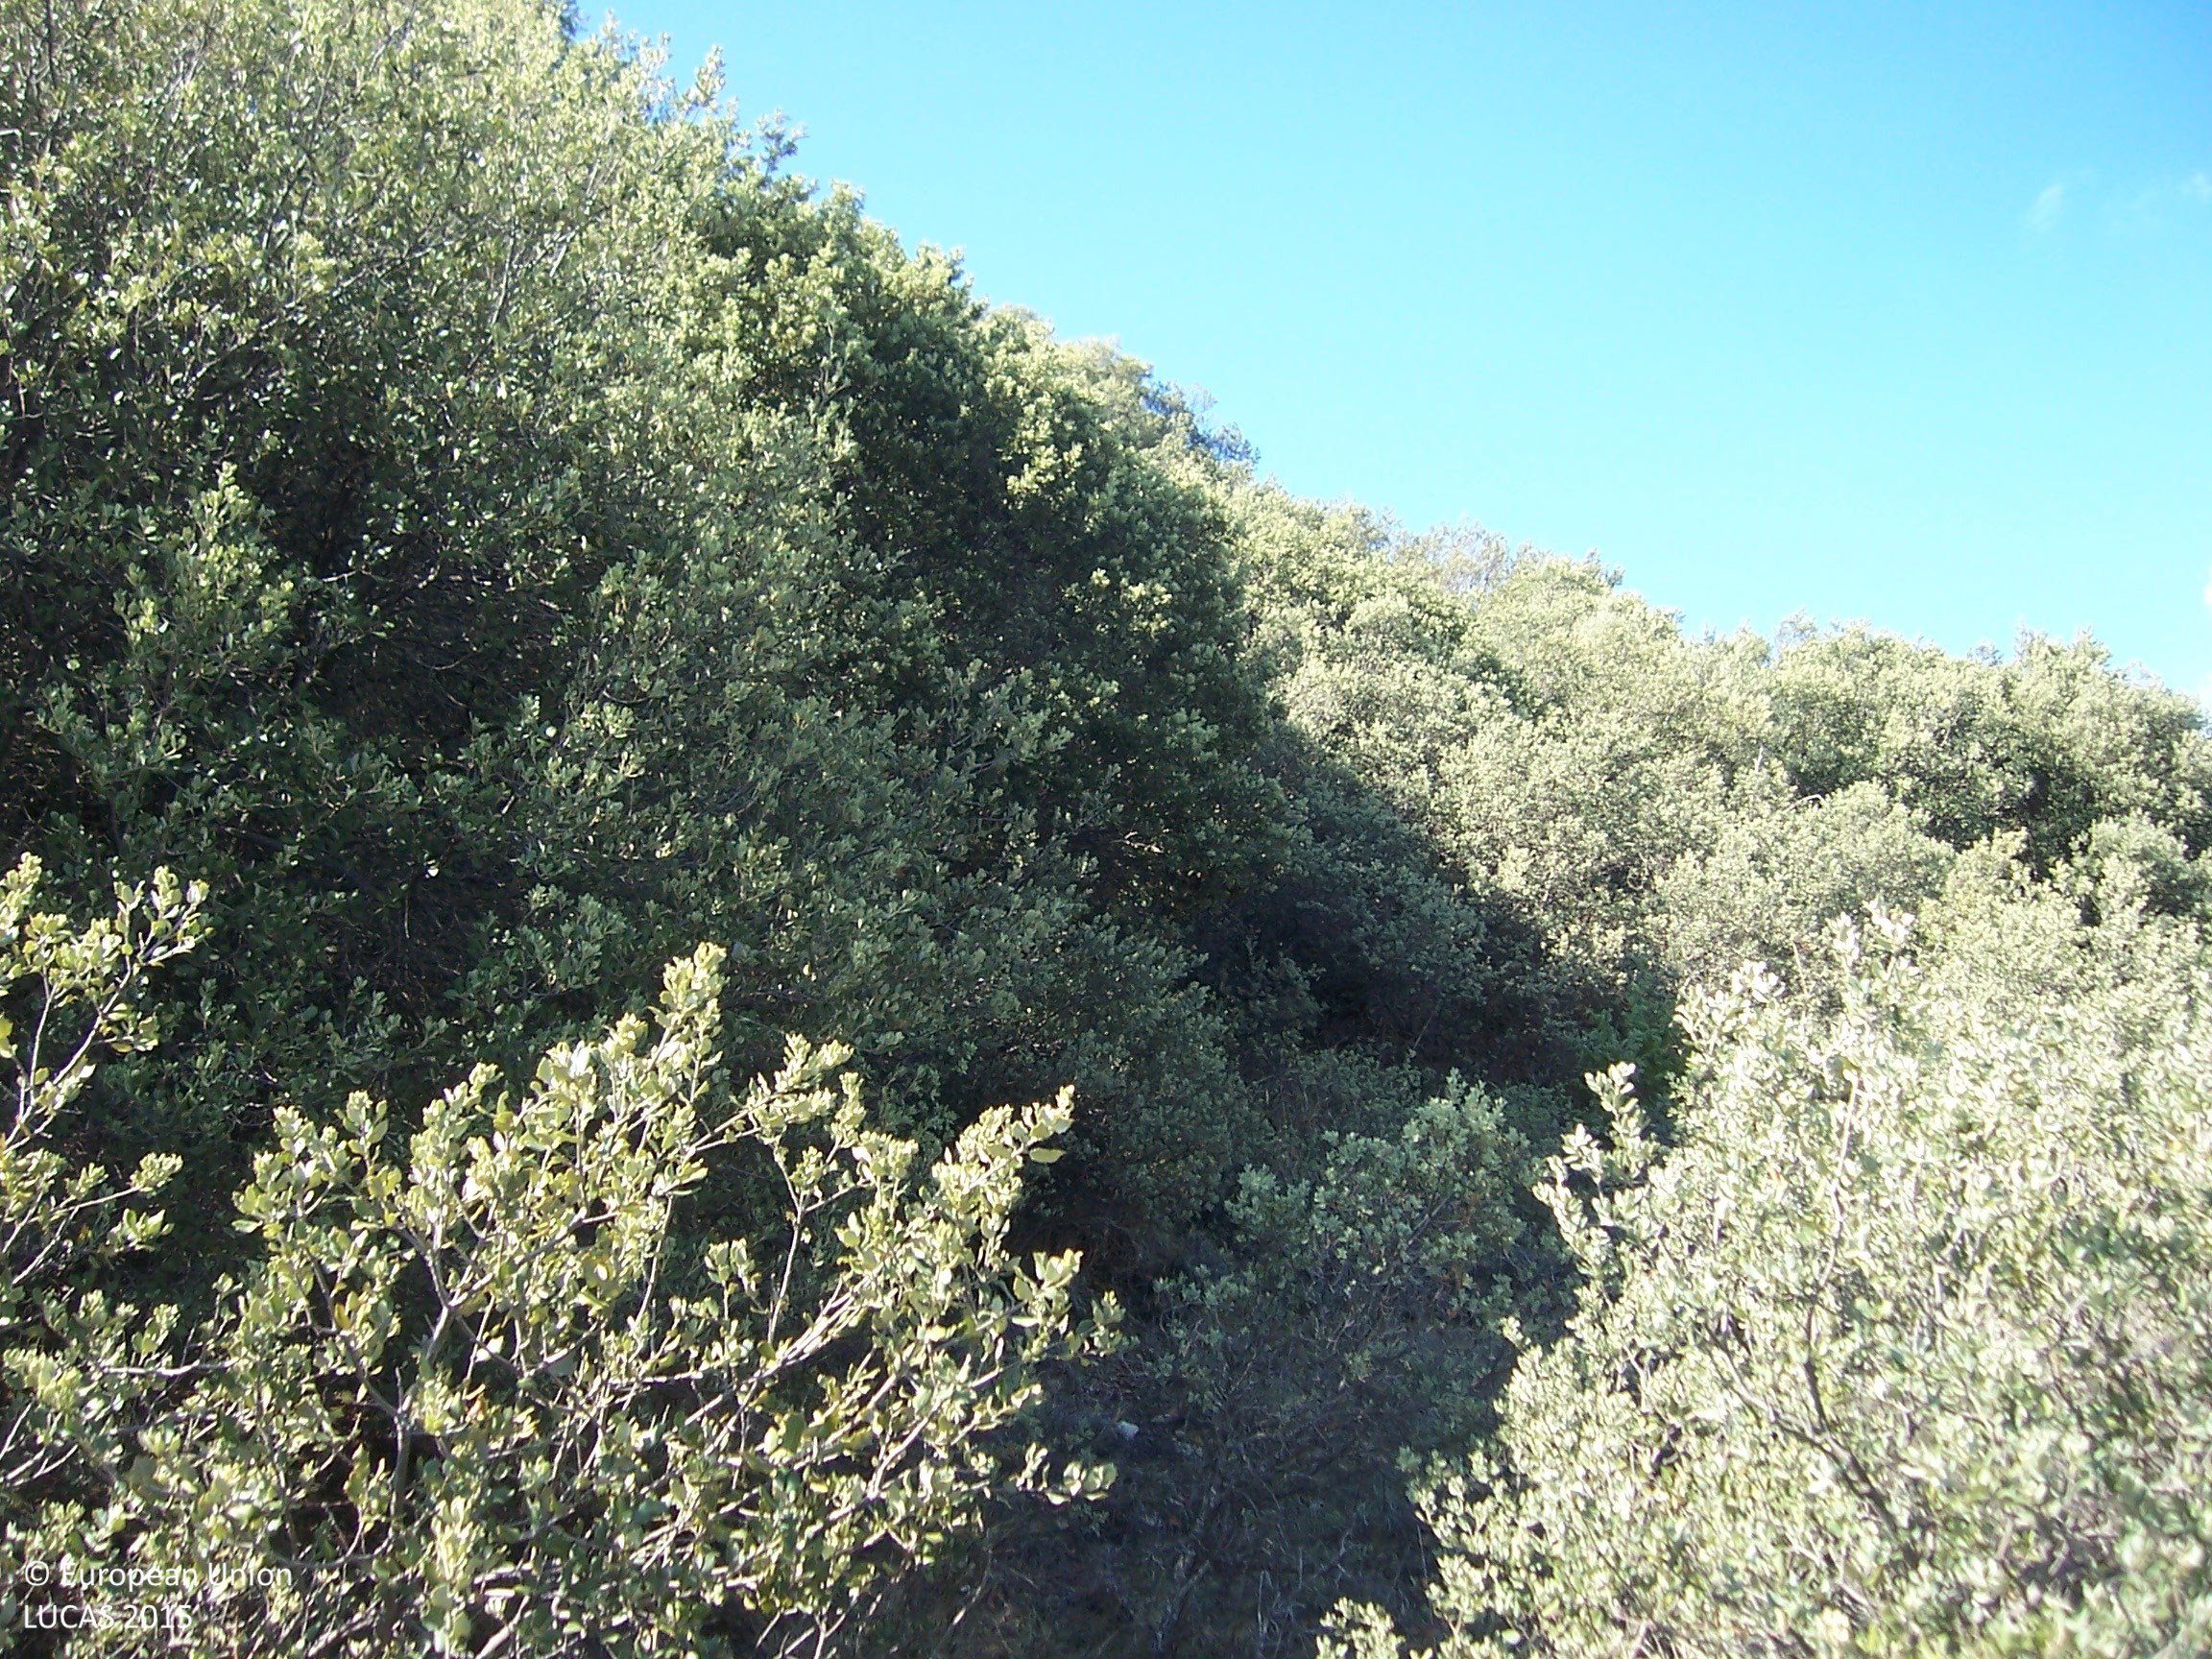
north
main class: Woodland
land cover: Broadleaved woodland
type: broadleaved evergreen forest
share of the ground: 25 - 50 %
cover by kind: broadleaved forest trees 30 %, shrubs 30 %, herbaceous plants 30 %, unconsolidated bare surface 10 %
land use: Semi-natural and natural areas not in use
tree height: < 5 m
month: August
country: ES
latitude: 42.2799
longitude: 0.3164
